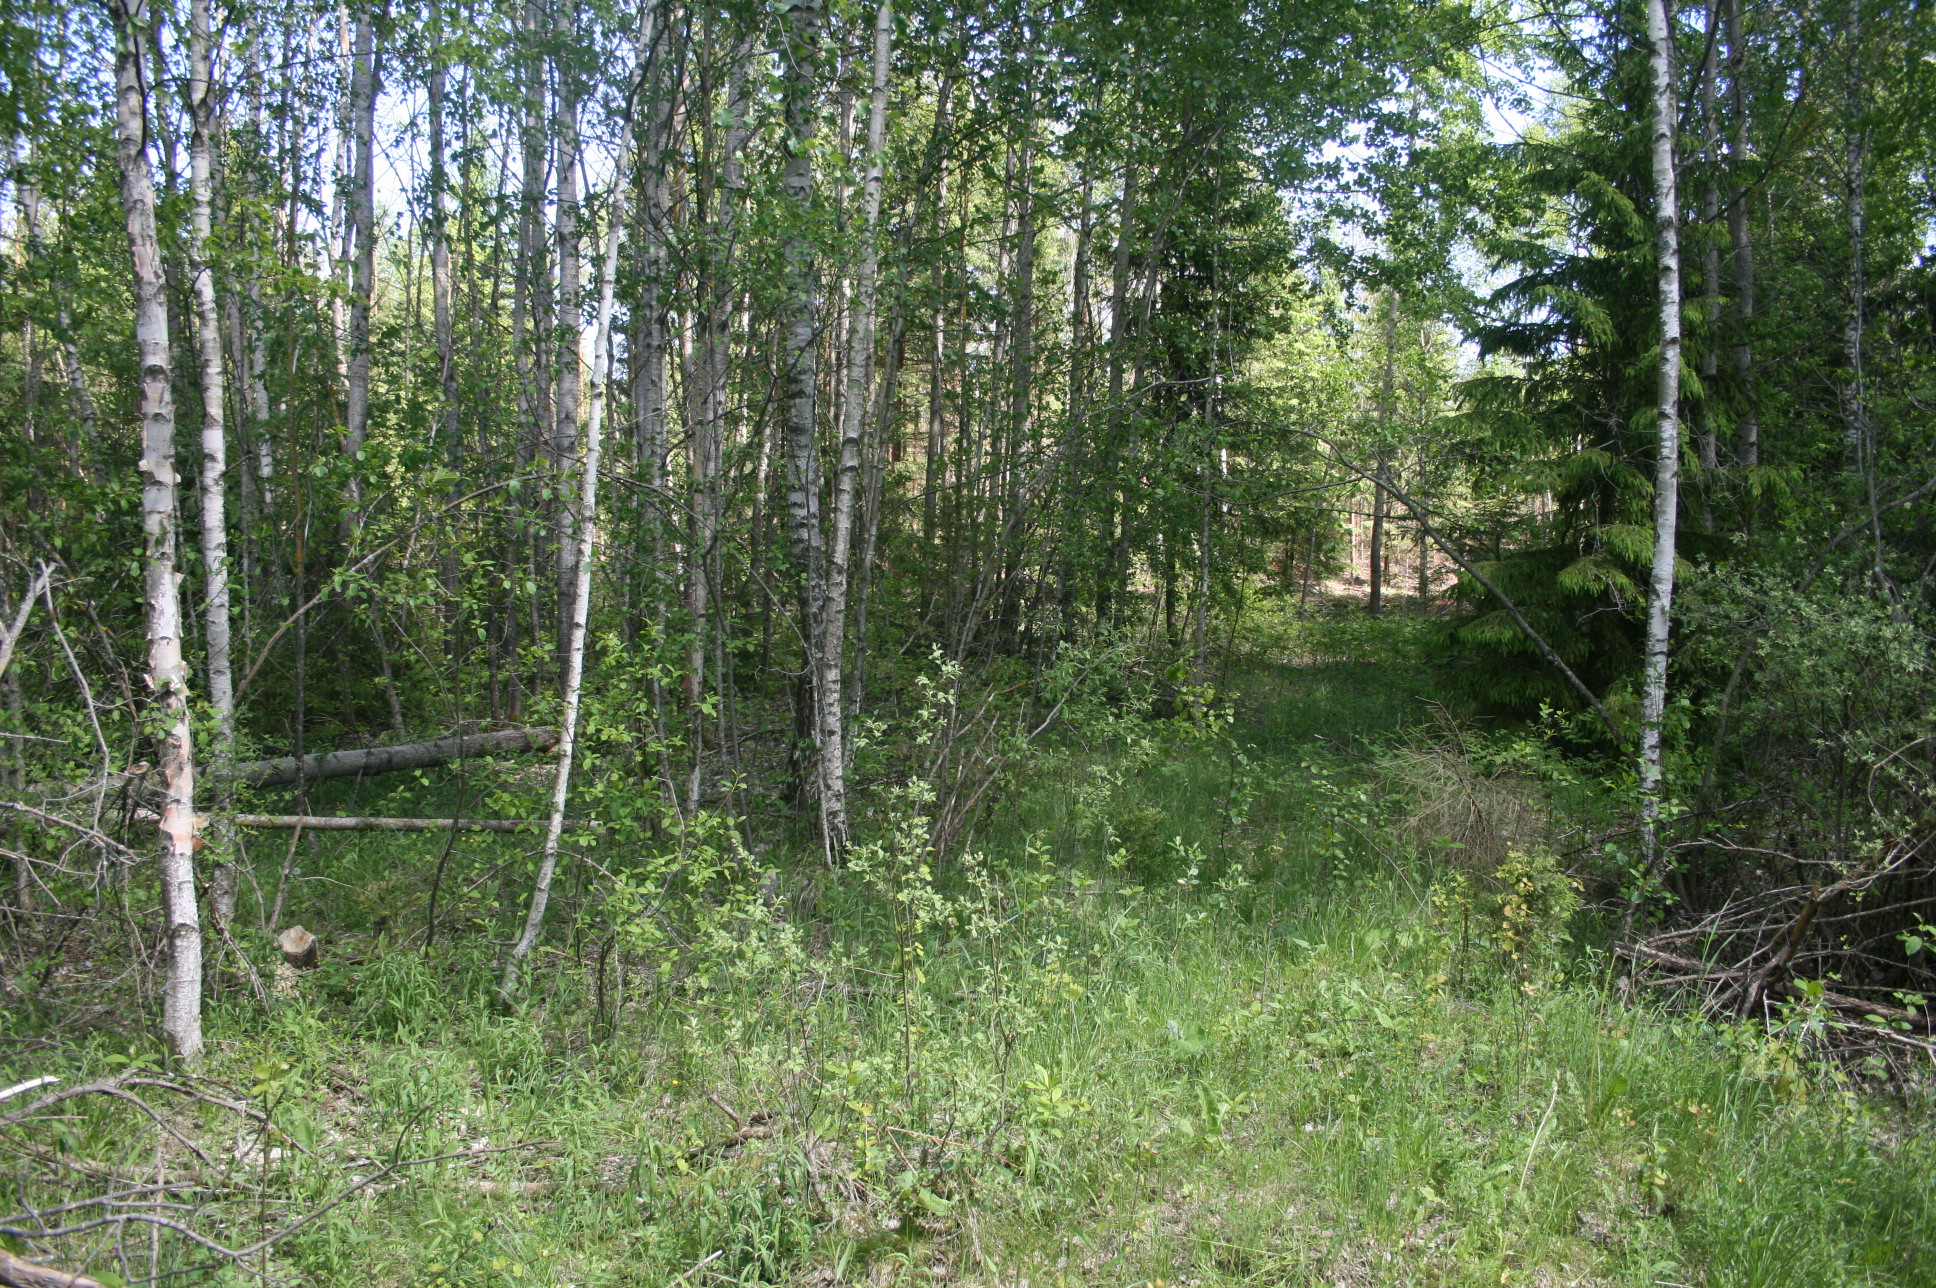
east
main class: Woodland
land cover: Broadleaved woodland
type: non-riverine alder, birch or aspen forest
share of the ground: > 75 %
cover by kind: broadleaved forest trees 85 %, herbaceous plants 10 %, coniferous forest trees 5 %
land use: Forestry
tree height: > 5 m
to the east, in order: Broadleaved woodland; Other mixed woodland; Spruce dominated mixed woodland; Other mixed woodland; Spruce dominated mixed woodland
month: June
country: LT
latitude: 56.0802
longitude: 22.3485
